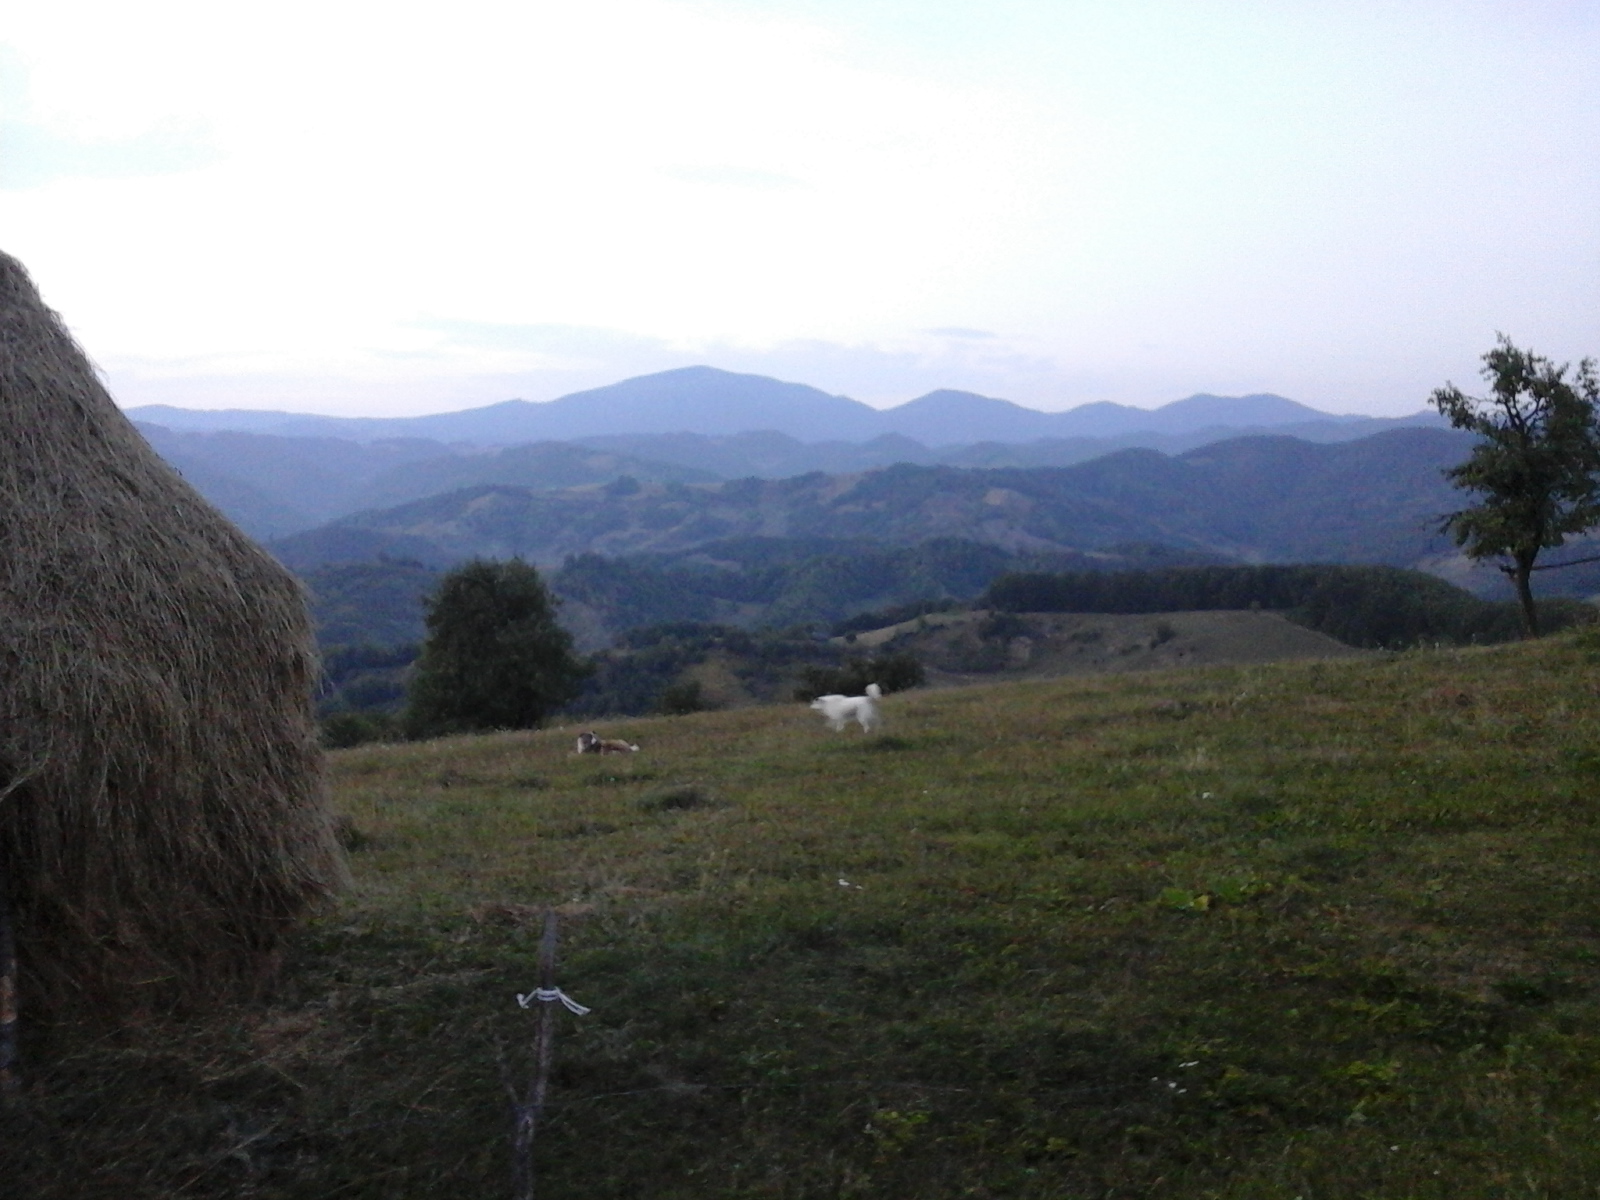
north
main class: Cropland
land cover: Nuts trees
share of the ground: > 75 %
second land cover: Grassland without tree/shrub cover
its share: > 75 %
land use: Agriculture (excluding fallow land and kitchen gardens)
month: September
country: RO
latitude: 47.4325
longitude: 24.1529
